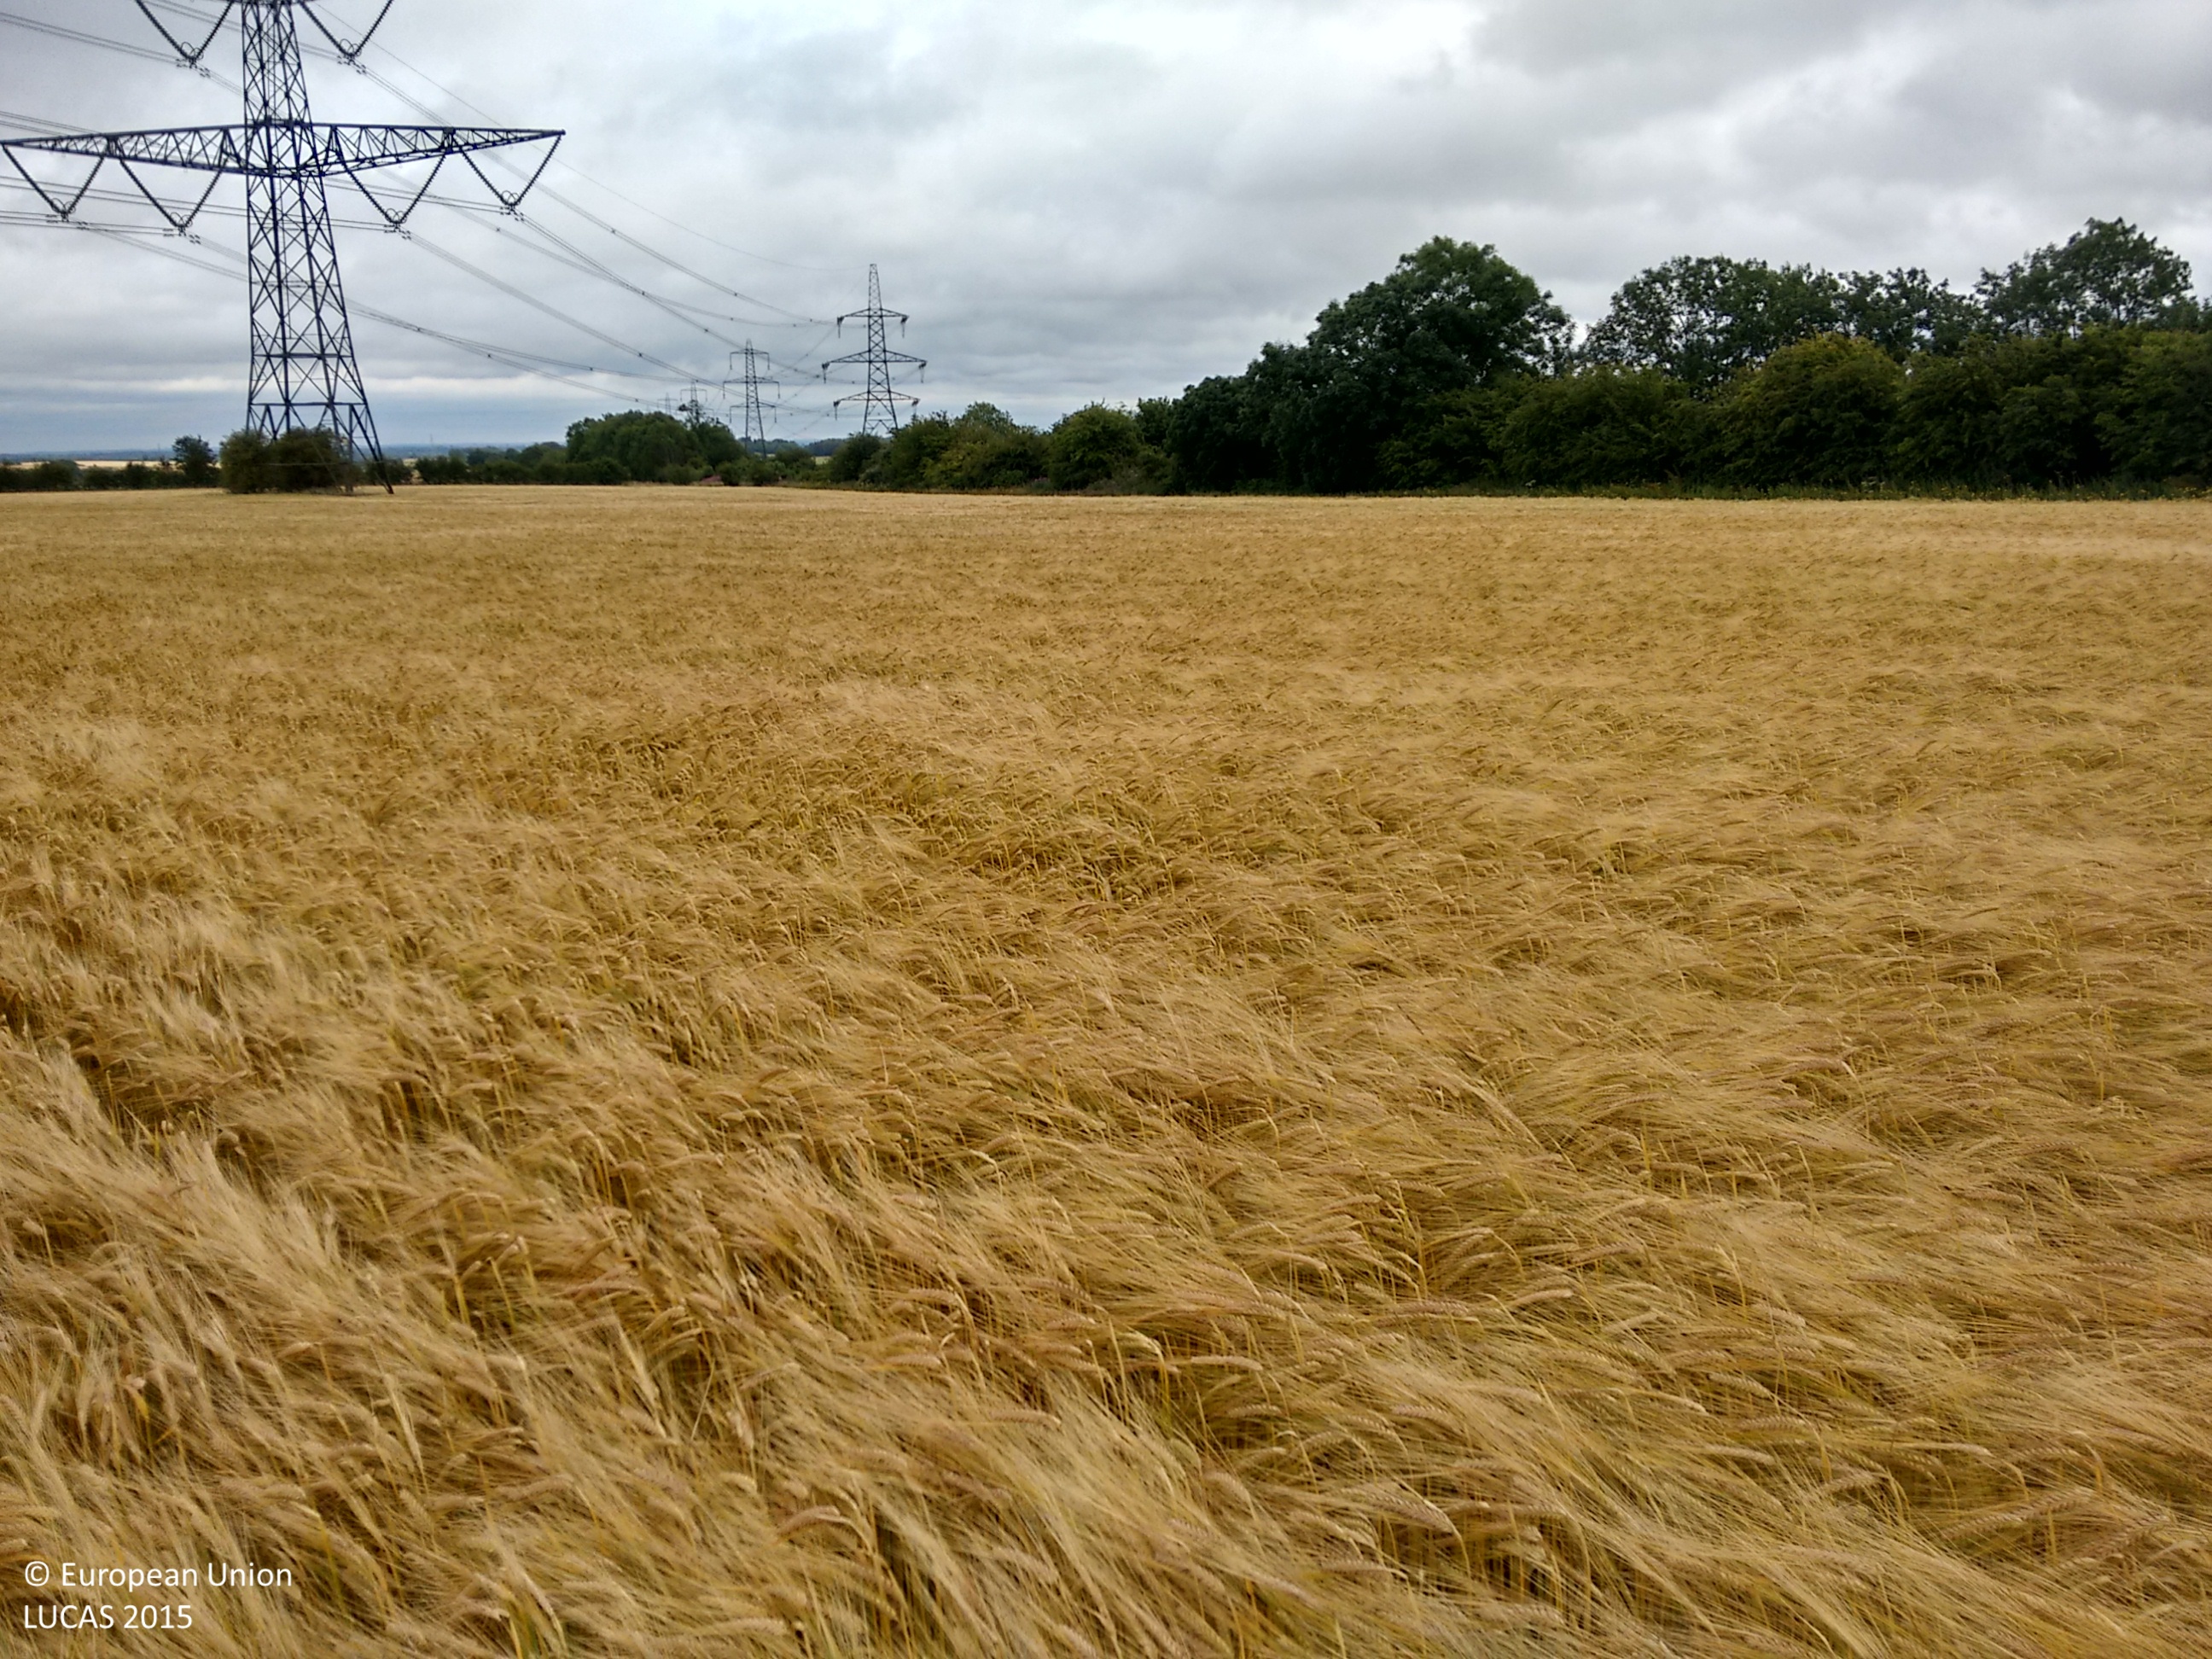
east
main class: Cropland
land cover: Barley
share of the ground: > 75 %
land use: Agriculture (excluding fallow land and kitchen gardens)
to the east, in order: Barley; Spontaneously vegetated surfaces; Electric lines; Abandoned hedges; Spontaneously vegetated surfaces; Abandoned hedges
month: July
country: GB
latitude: 51.4930
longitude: -2.3500
